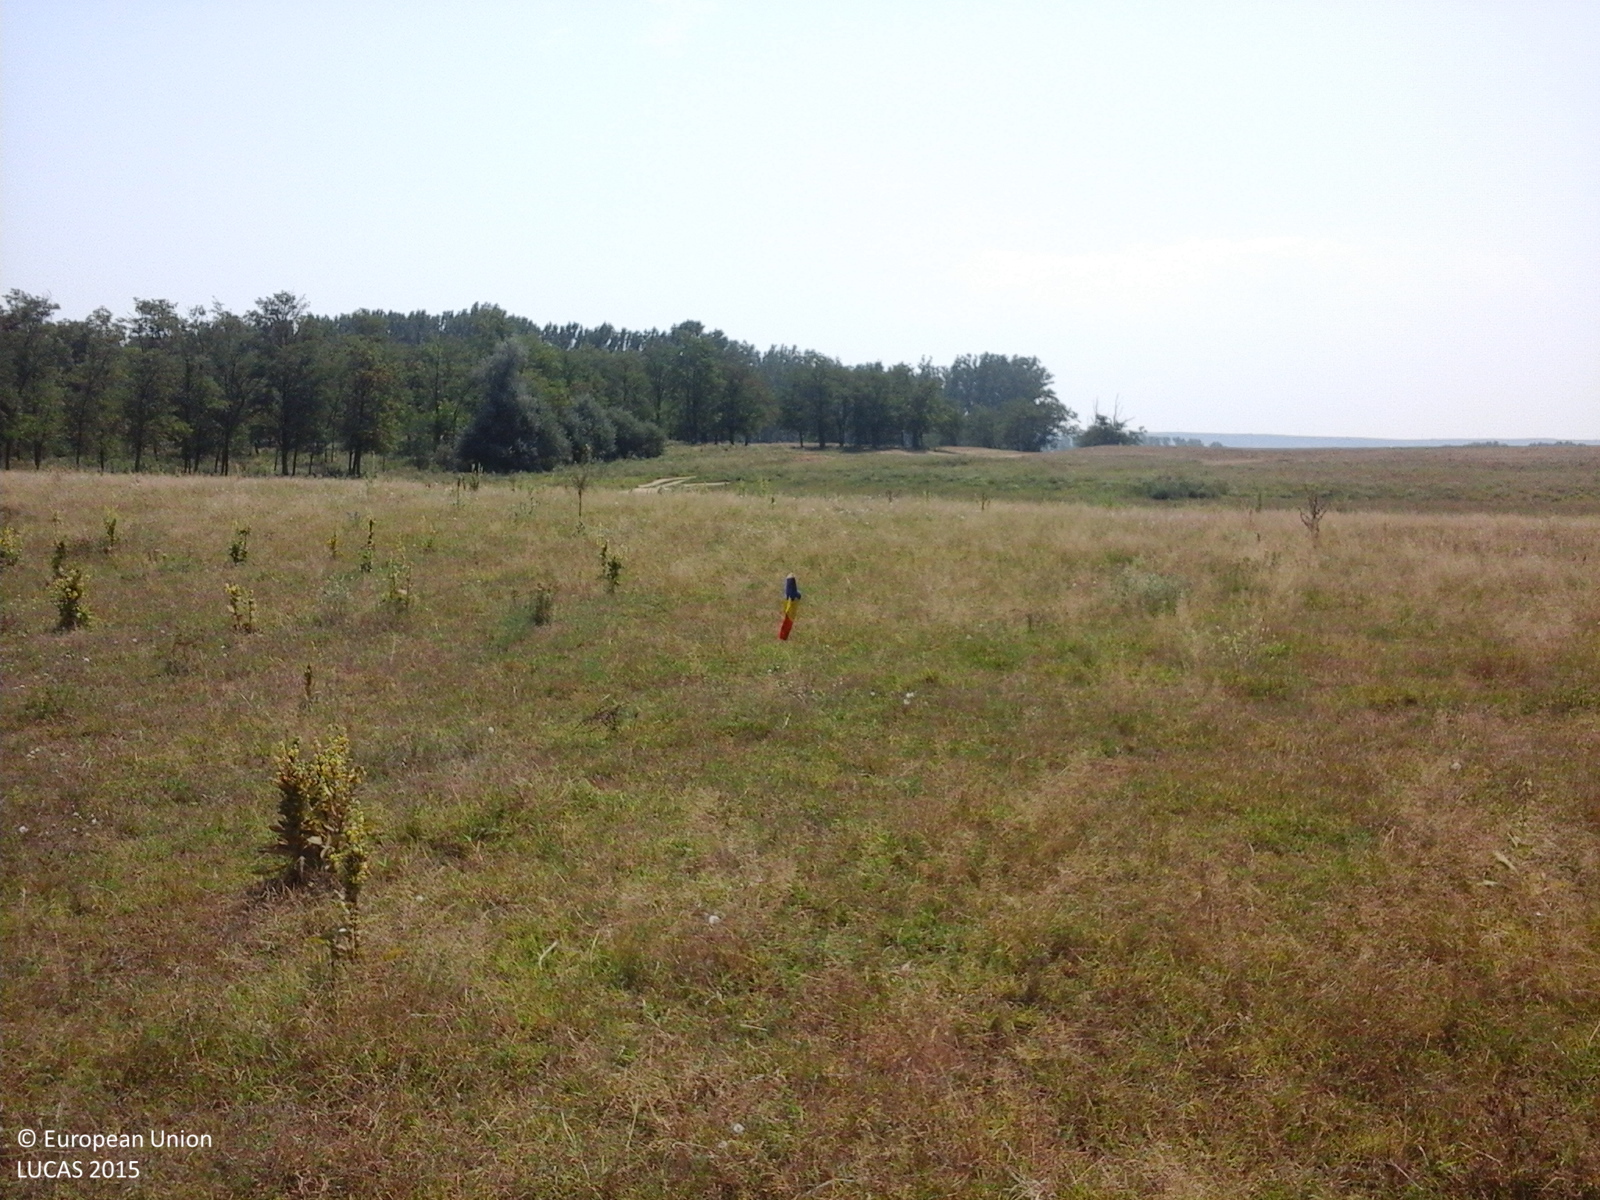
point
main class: Grassland
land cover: Grassland without tree/shrub cover
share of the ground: > 75 %
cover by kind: herbaceous plants 100 %
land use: Agriculture (excluding fallow land and kitchen gardens)
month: August
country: RO
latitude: 43.8542
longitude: 23.1674
